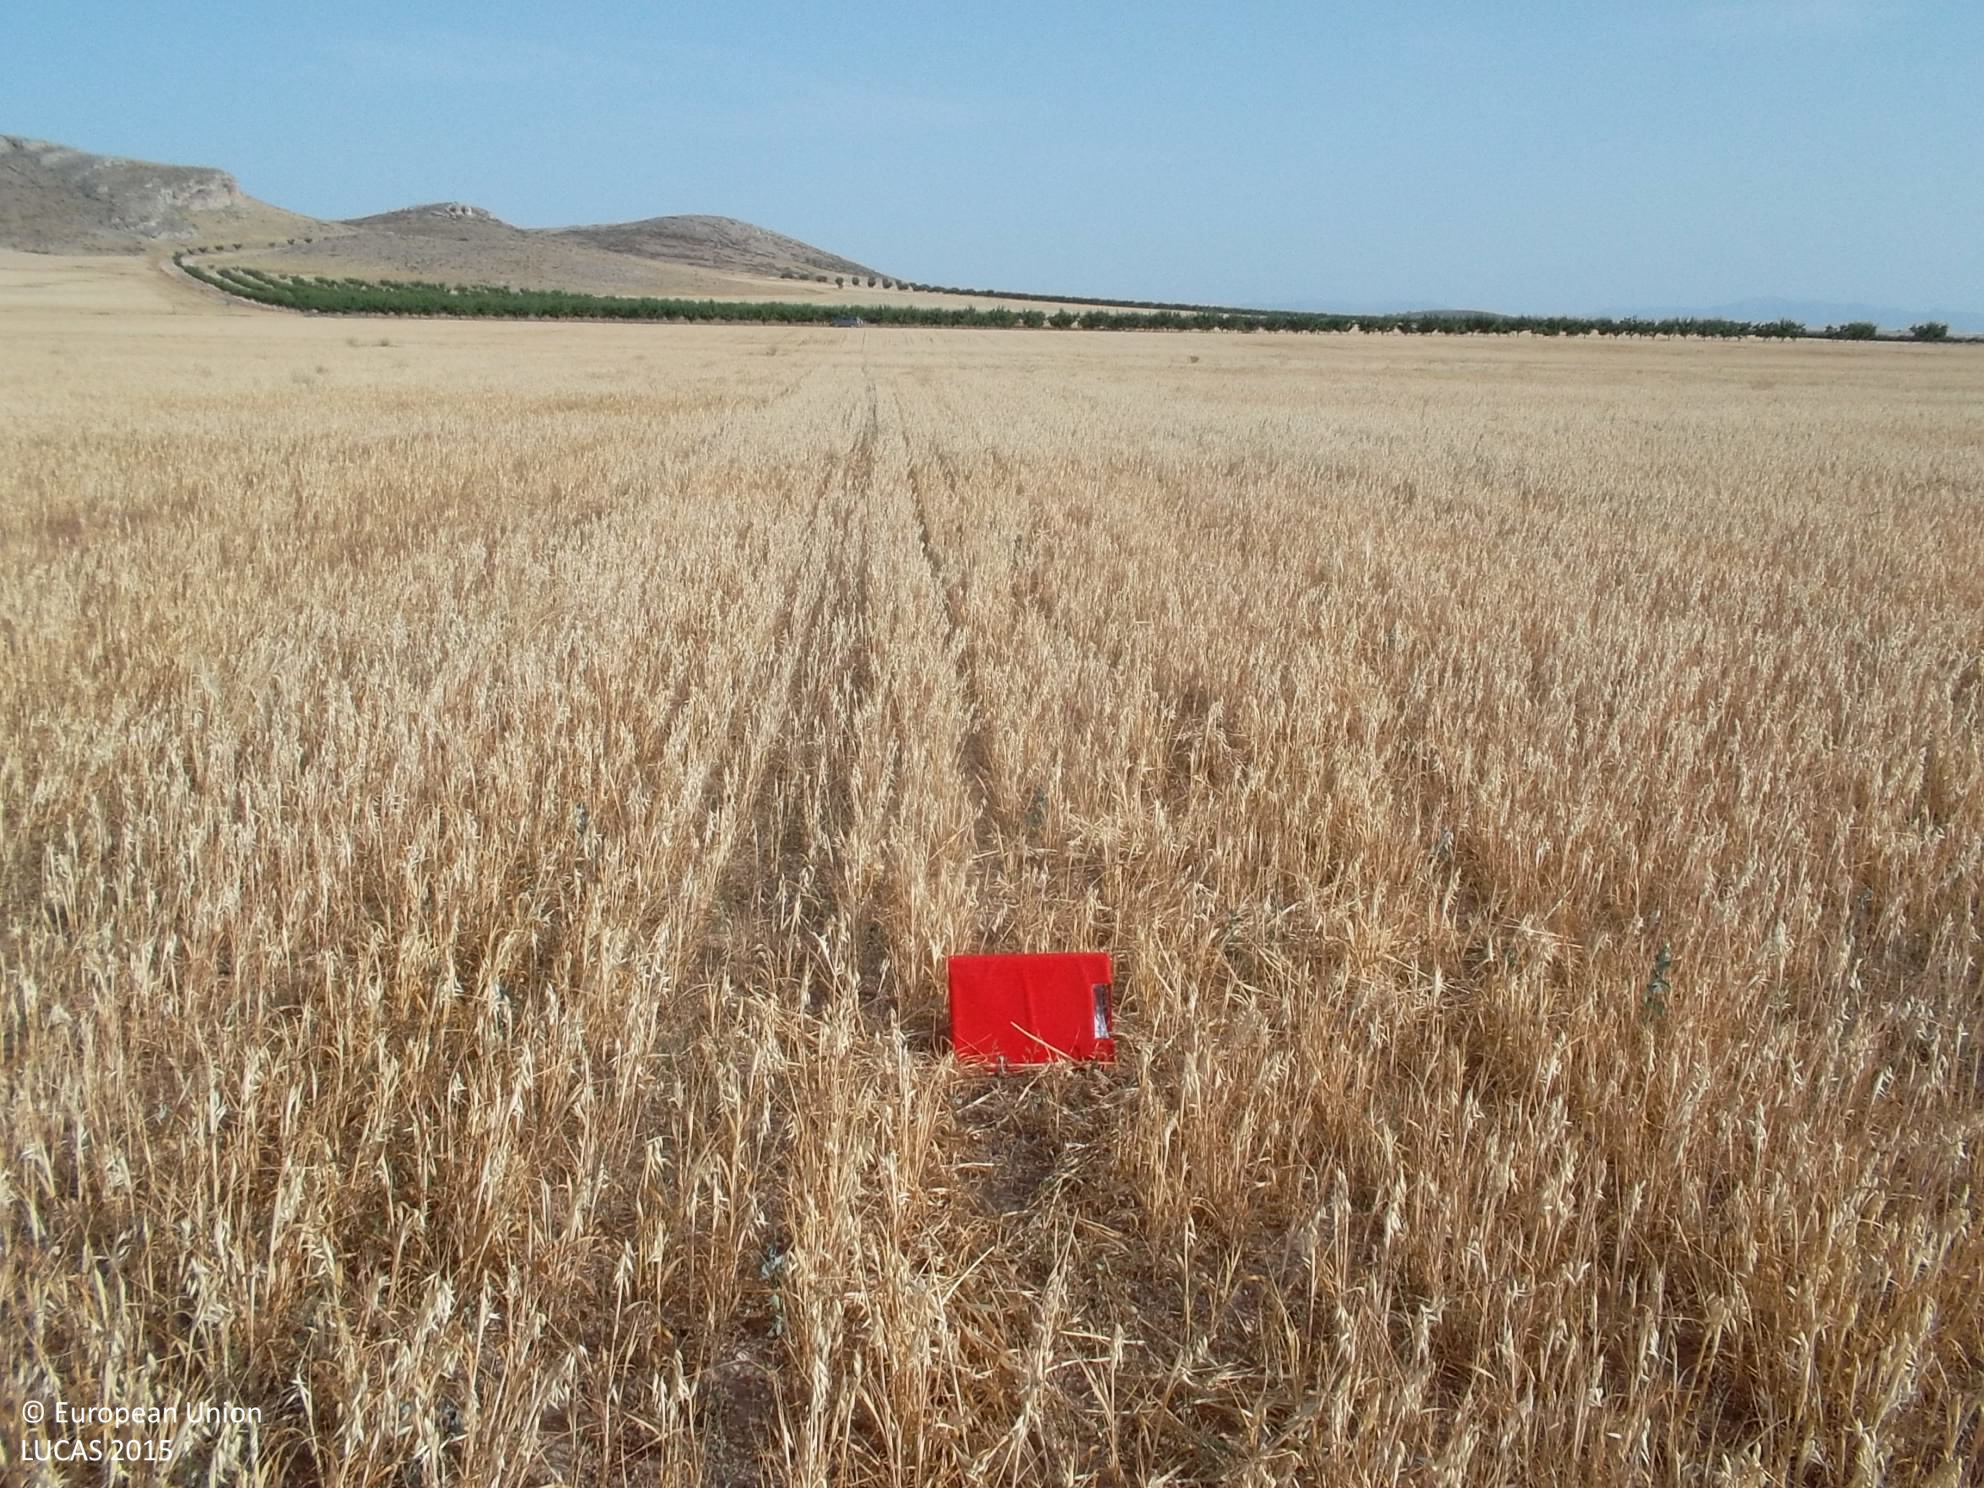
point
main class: Cropland
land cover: Oats
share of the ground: > 75 %
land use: Agriculture (excluding fallow land and kitchen gardens)
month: July
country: ES
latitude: 37.8918
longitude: -2.3502
